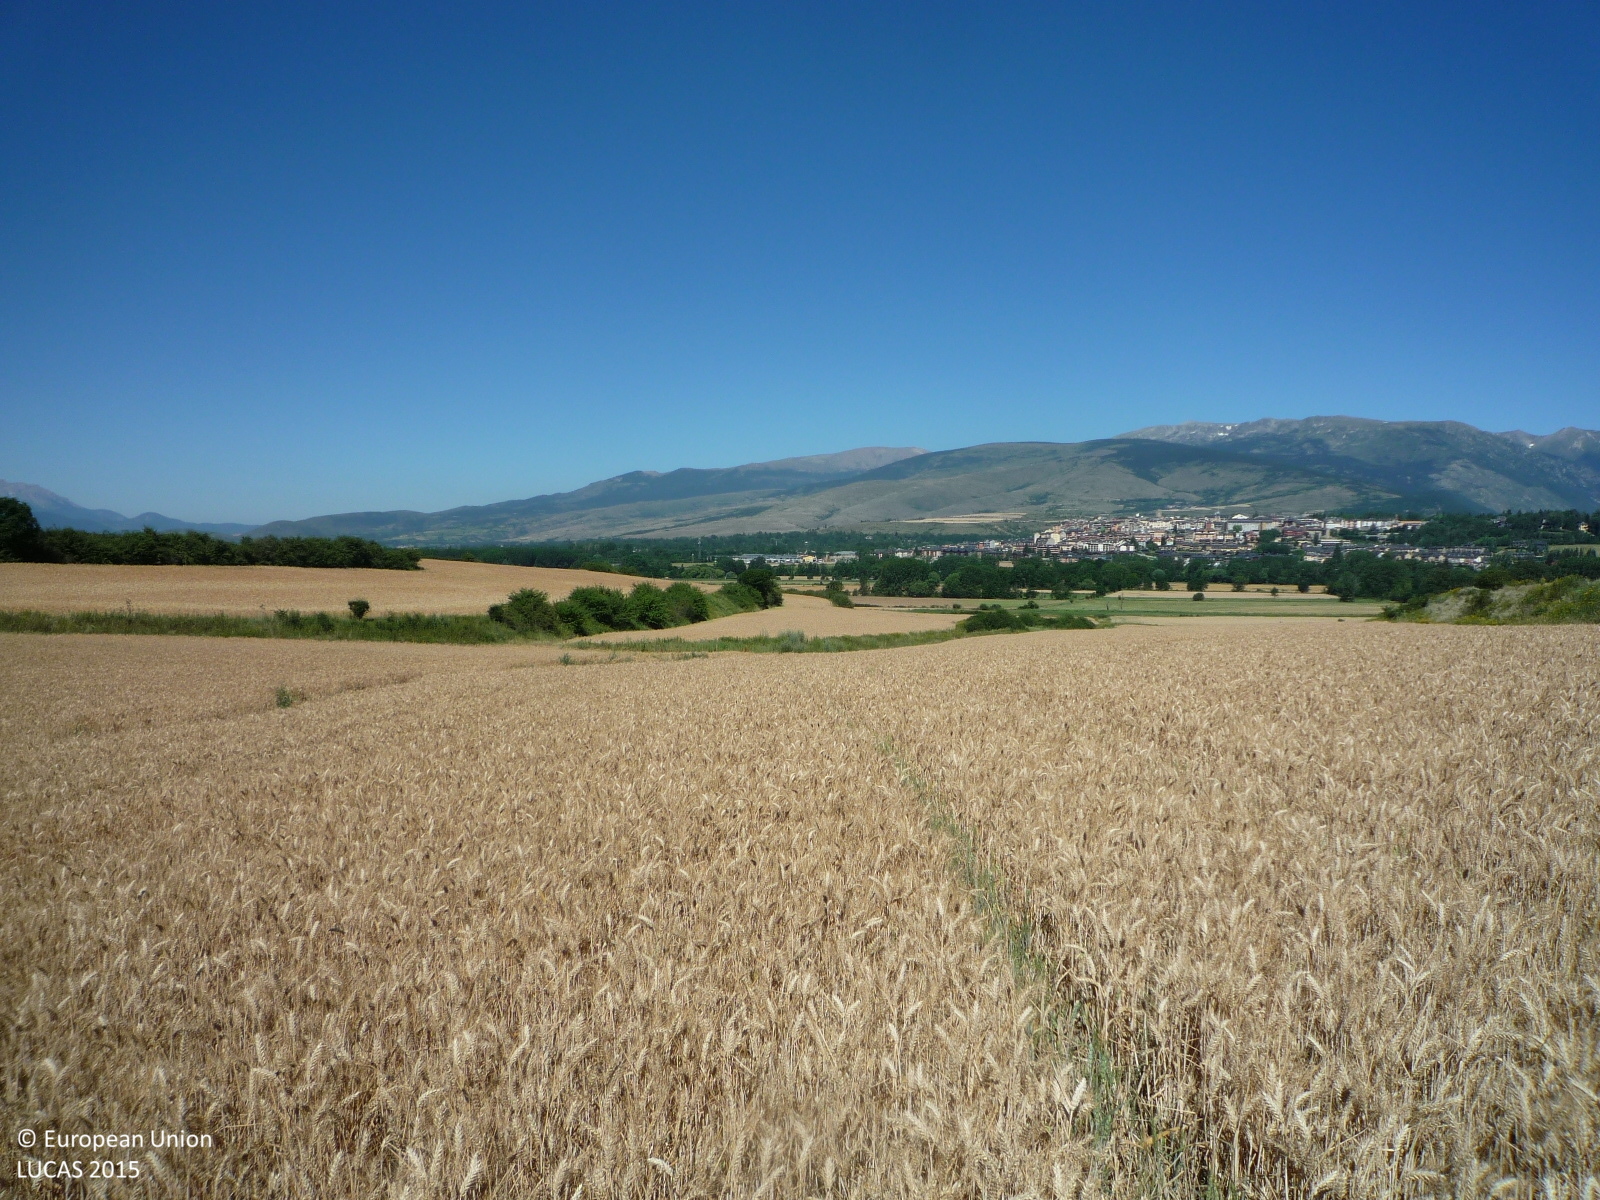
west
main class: Cropland
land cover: Common wheat
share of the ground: > 75 %
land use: Agriculture (excluding fallow land and kitchen gardens)
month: July
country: ES
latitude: 42.4242
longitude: 1.9532
